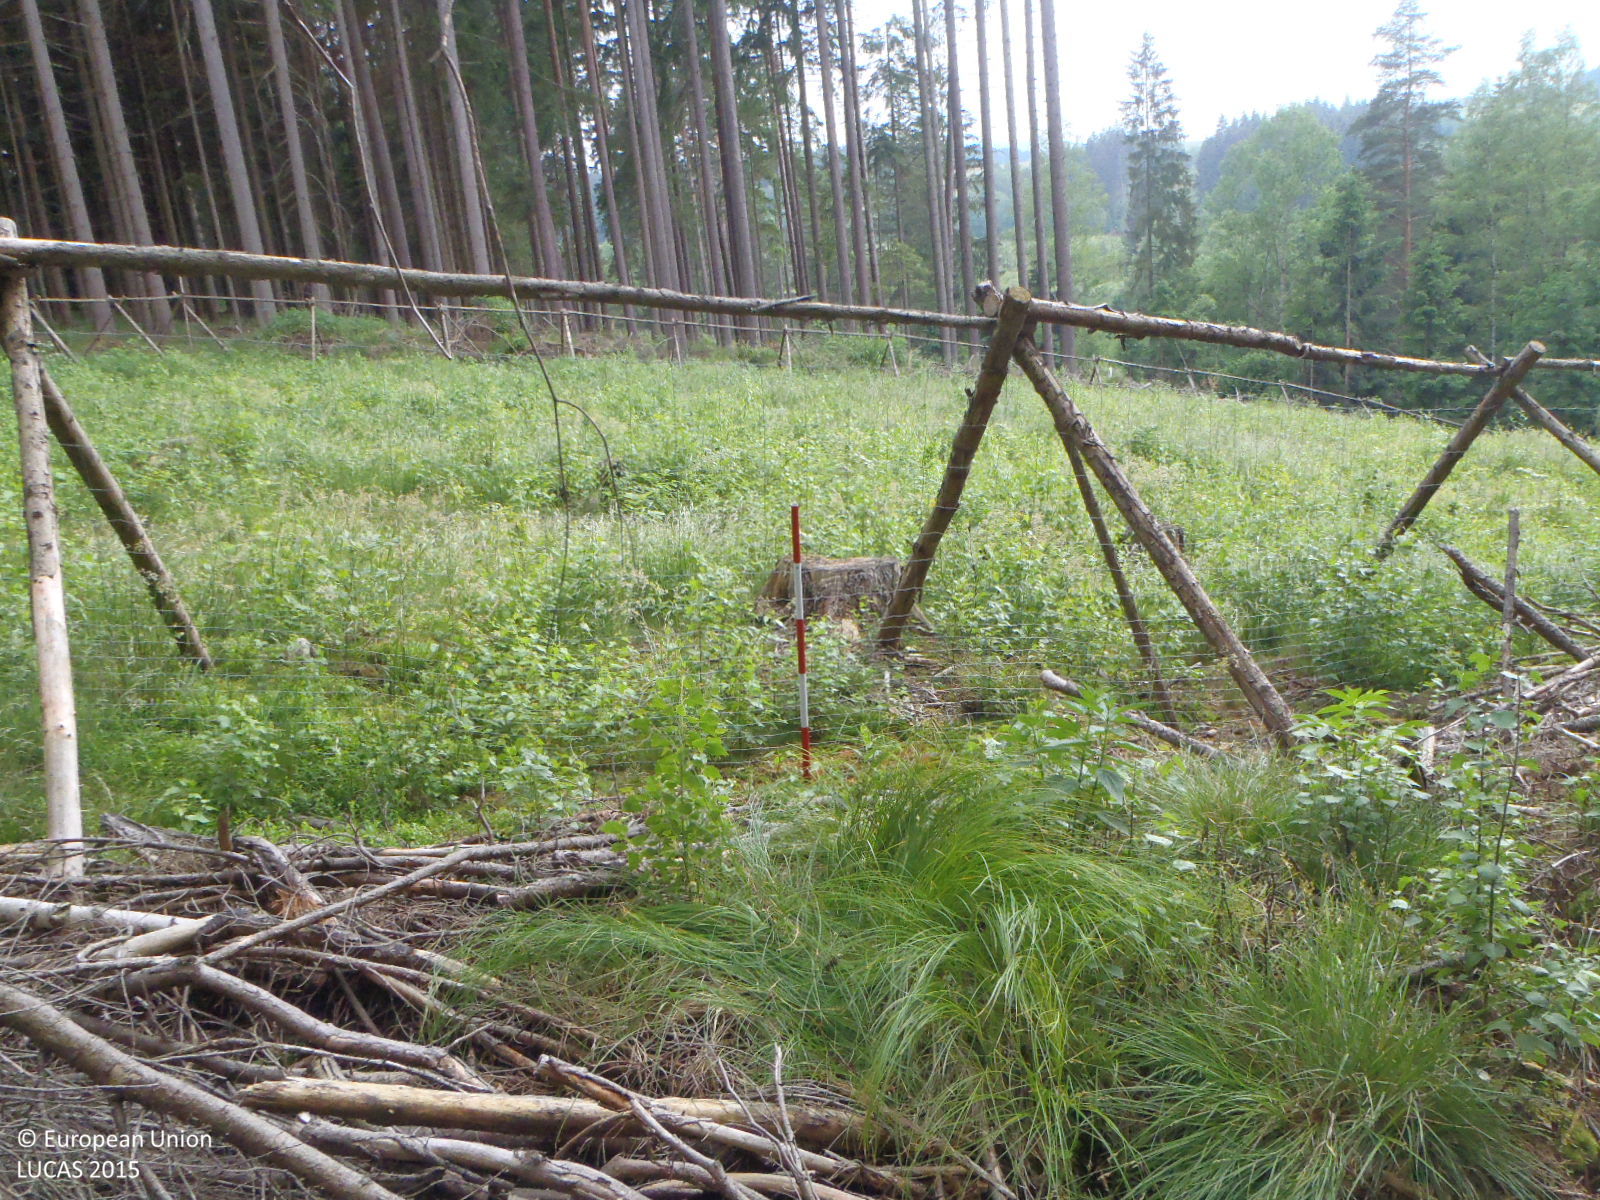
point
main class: Woodland
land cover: Other coniferous woodland
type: hemiboreal forest and nemoral coniferous forest and mixed broadleaved-coniferous forest
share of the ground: > 75 %
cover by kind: coniferous forest trees 75 %, shrubs 10 %, herbaceous plants 10 %, lichens and mosses 5 %
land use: Forestry
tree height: > 5 m
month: June
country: CZ
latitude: 48.6240
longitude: 14.3555
